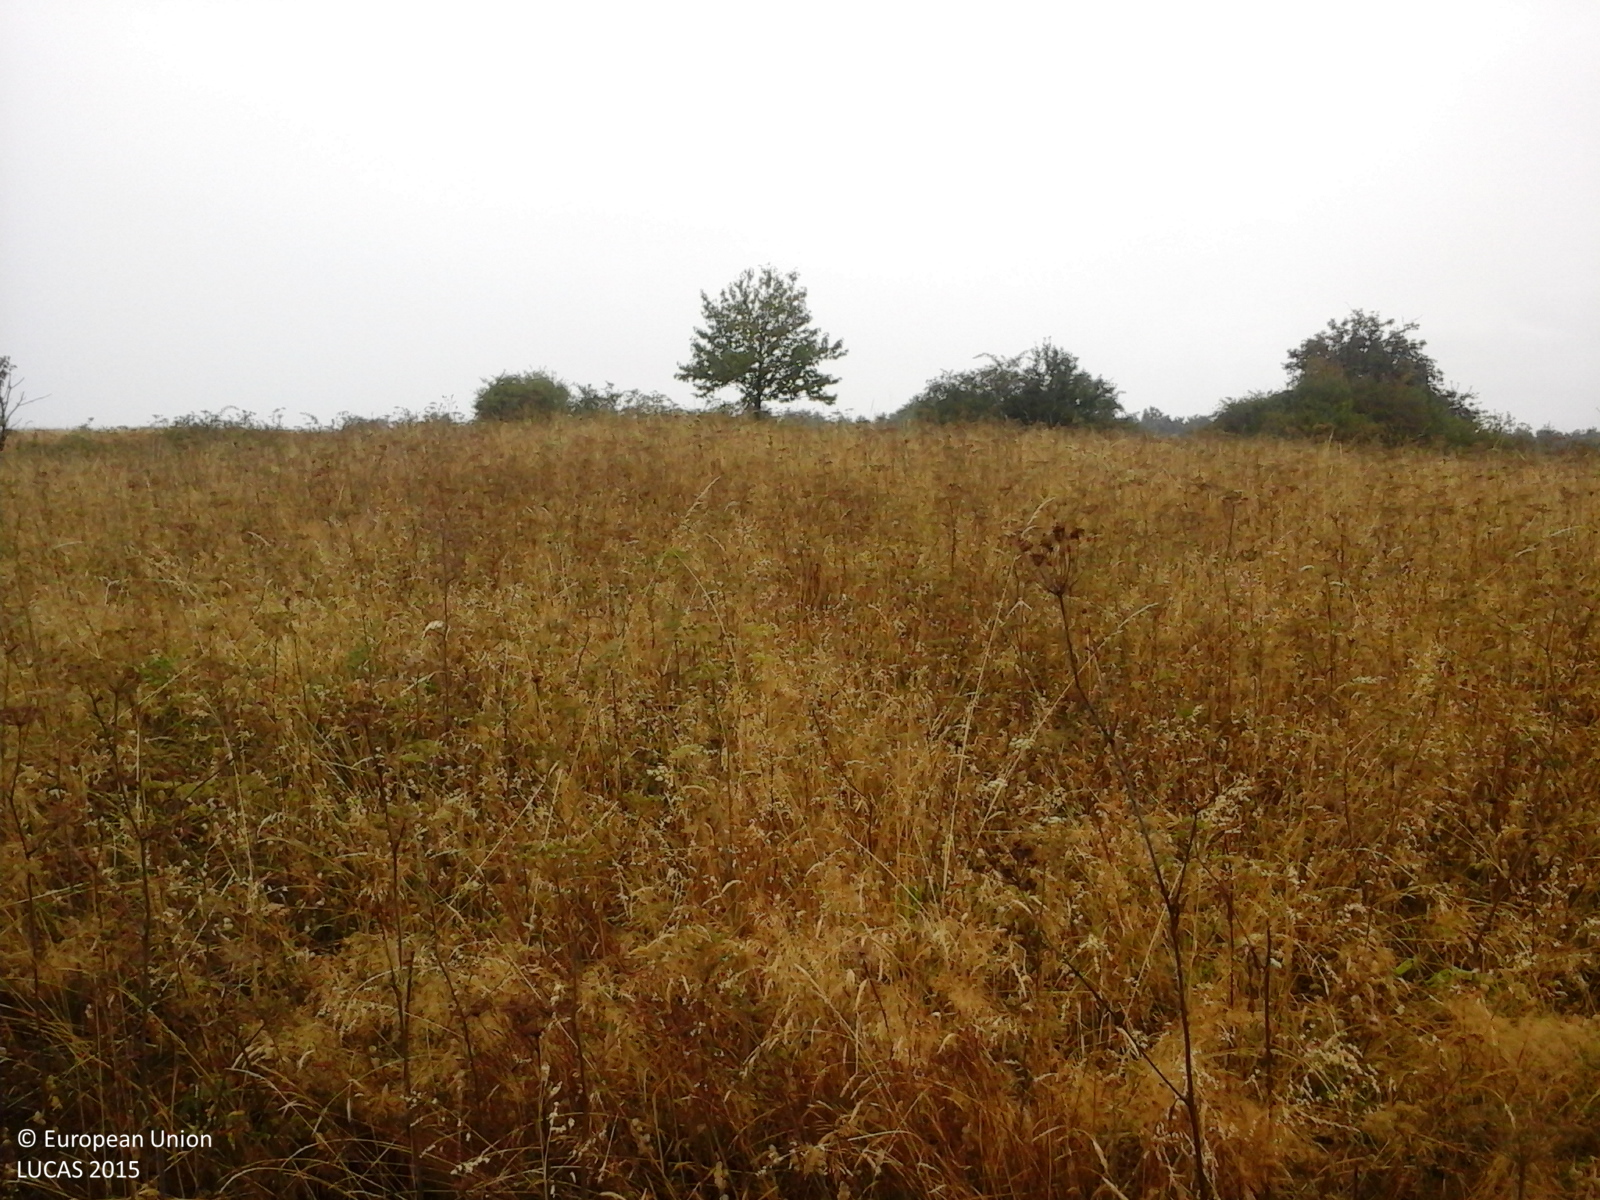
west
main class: Grassland
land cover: Spontaneously vegetated surfaces
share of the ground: > 75 %
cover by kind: herbaceous plants 100 %
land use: Fallow land
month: August
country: RO
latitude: 44.5620
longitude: 22.1587
